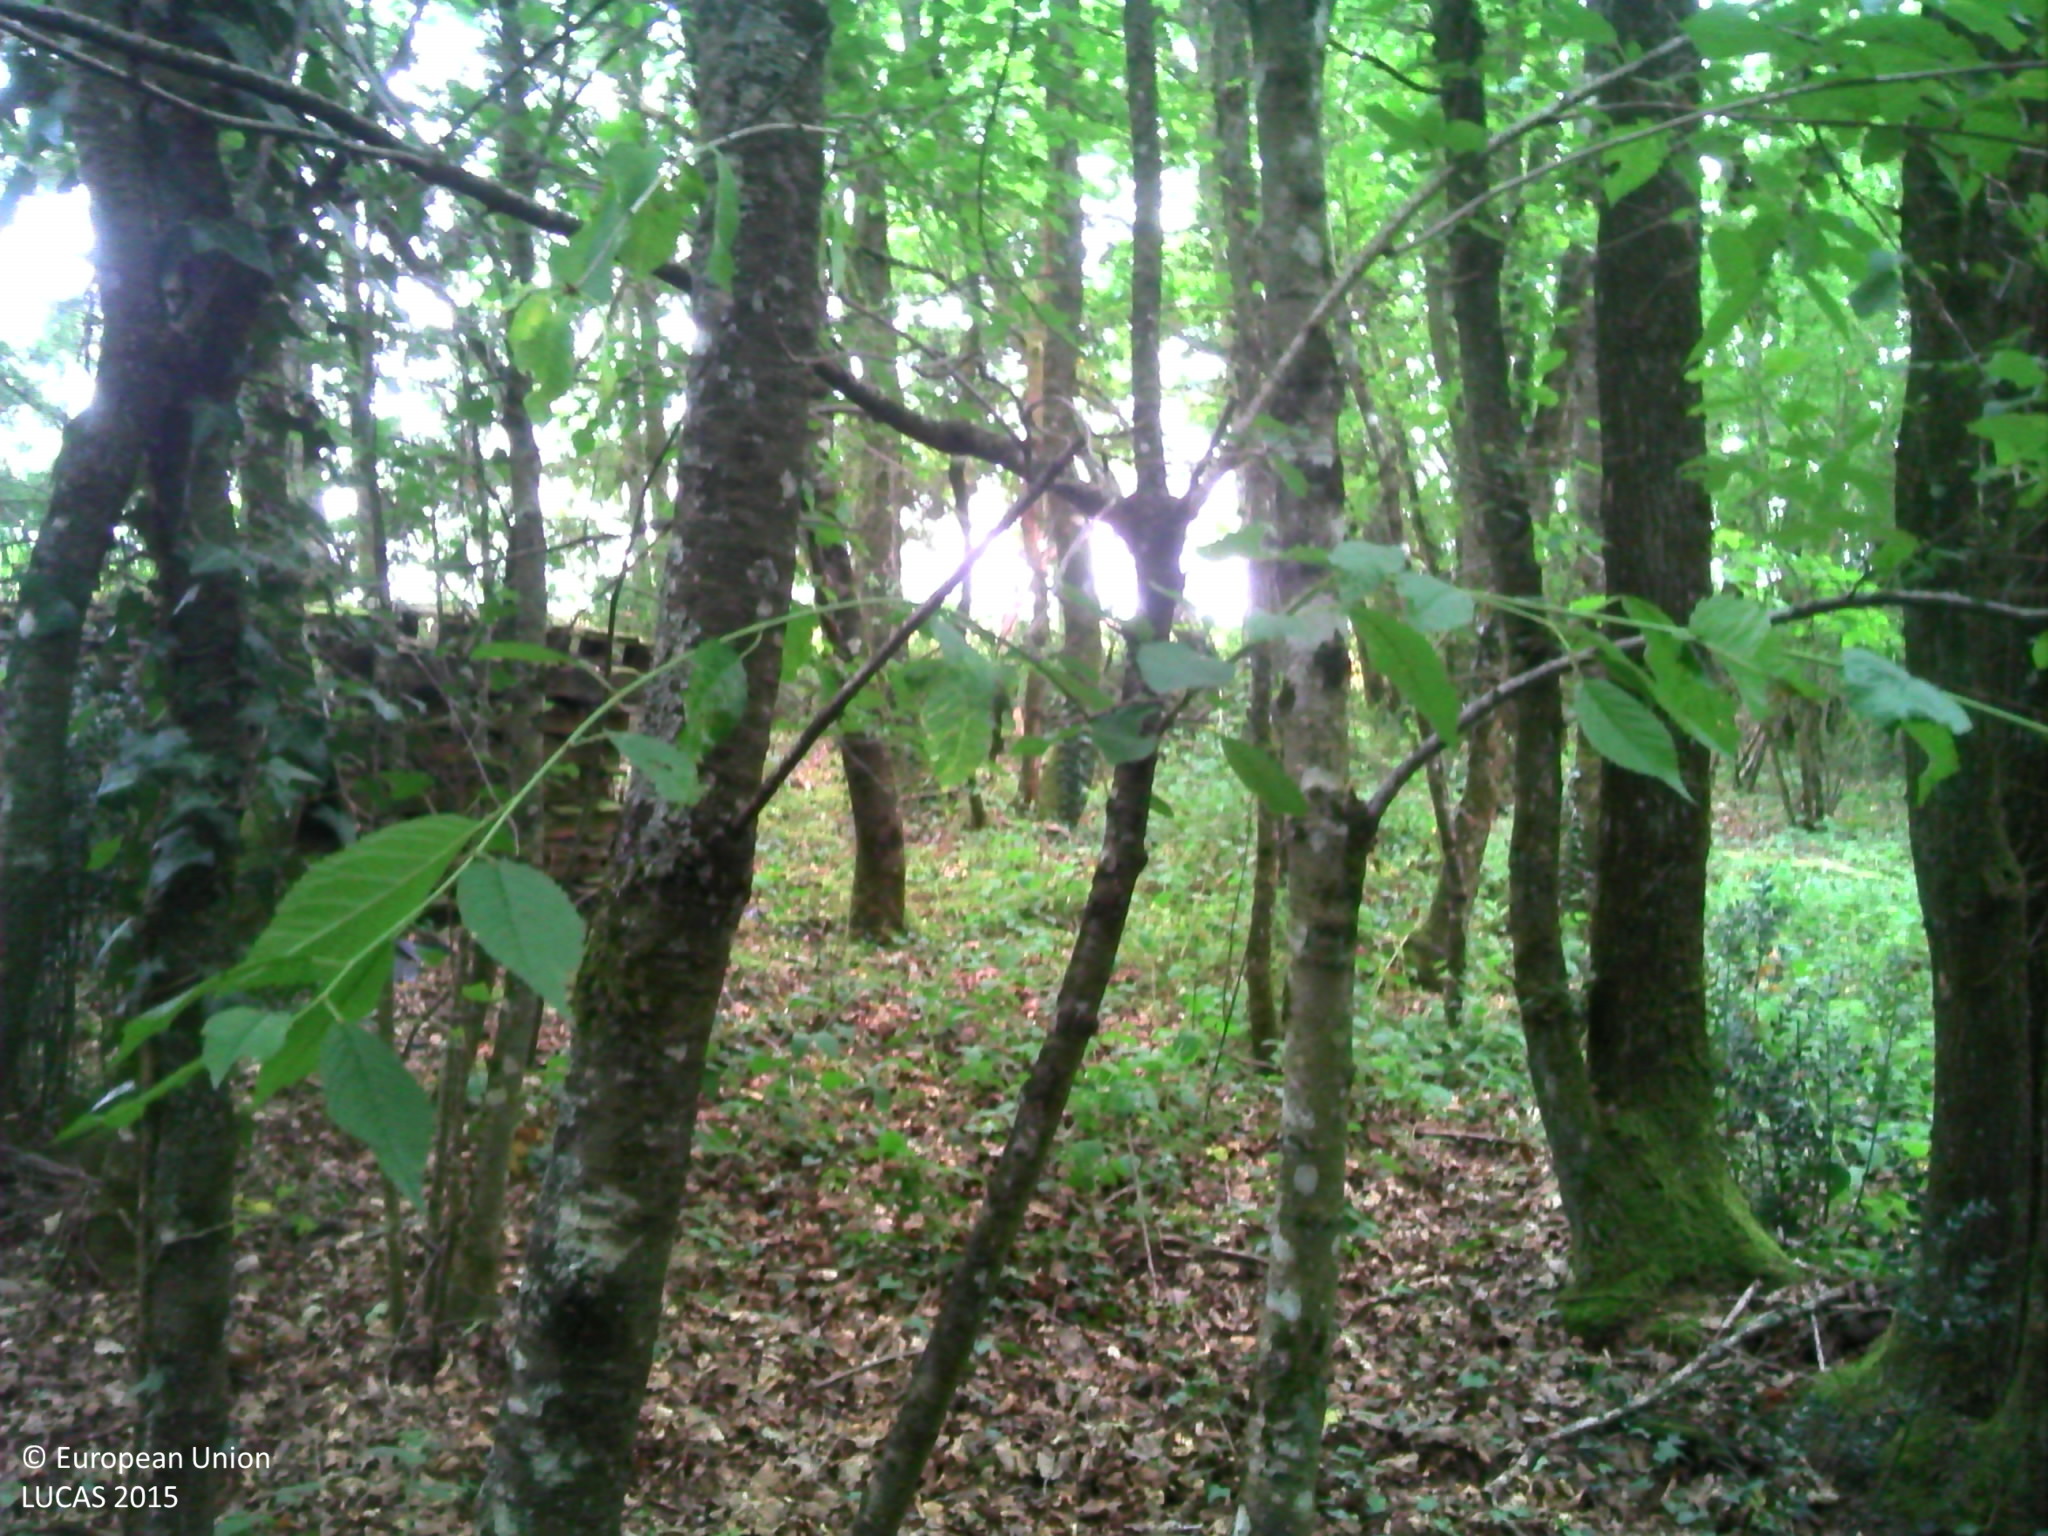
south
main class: Woodland
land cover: Broadleaved woodland
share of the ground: > 75 %
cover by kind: broadleaved forest trees 65 %, coniferous forest trees 10 %, shrubs 10 %, herbaceous plants 10 %, lichens and mosses 5 %
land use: Forestry
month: June
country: FR
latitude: 47.5638
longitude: 0.9840
